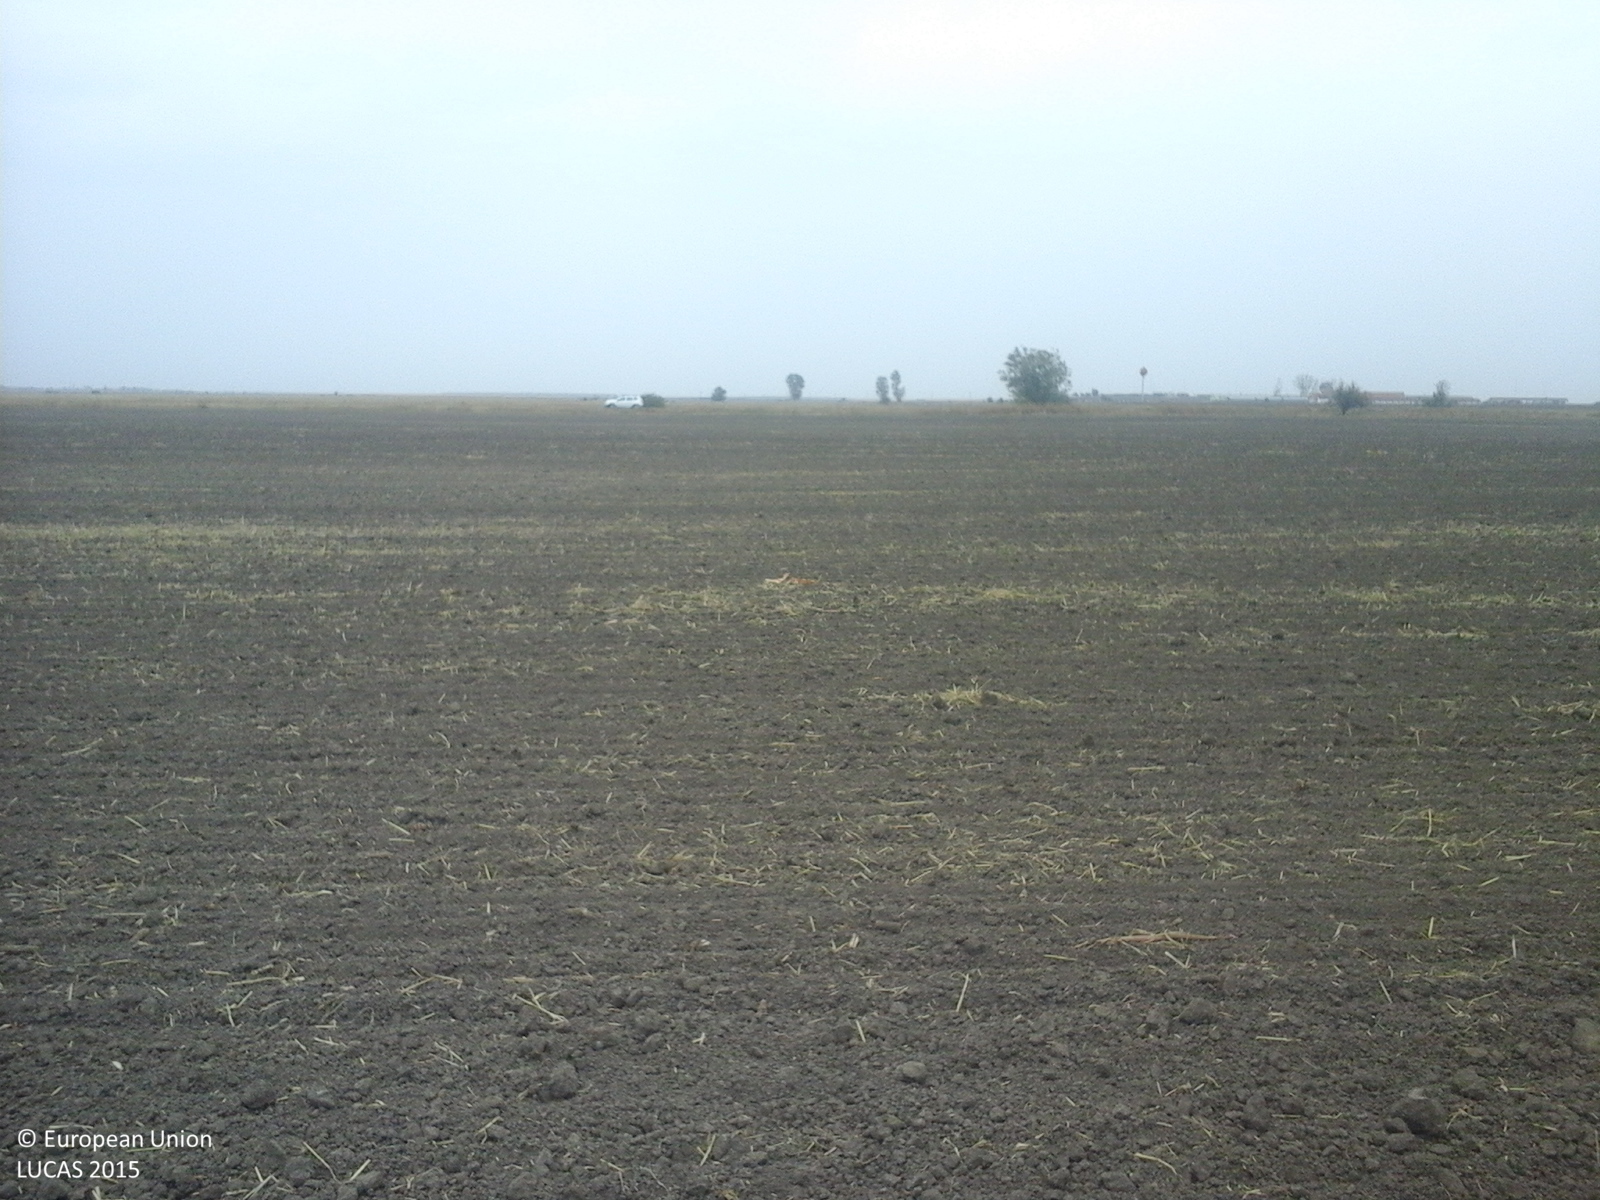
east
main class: Cropland
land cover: Common wheat
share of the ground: < 10 %
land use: Agriculture (excluding fallow land and kitchen gardens)
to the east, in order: Common wheat; Ditches and canals; Grass margins; Tracks; Grass margins; Ditches and canals; Grassland without tree/shrub cover
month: September
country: RO
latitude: 47.6683
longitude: 22.5372
